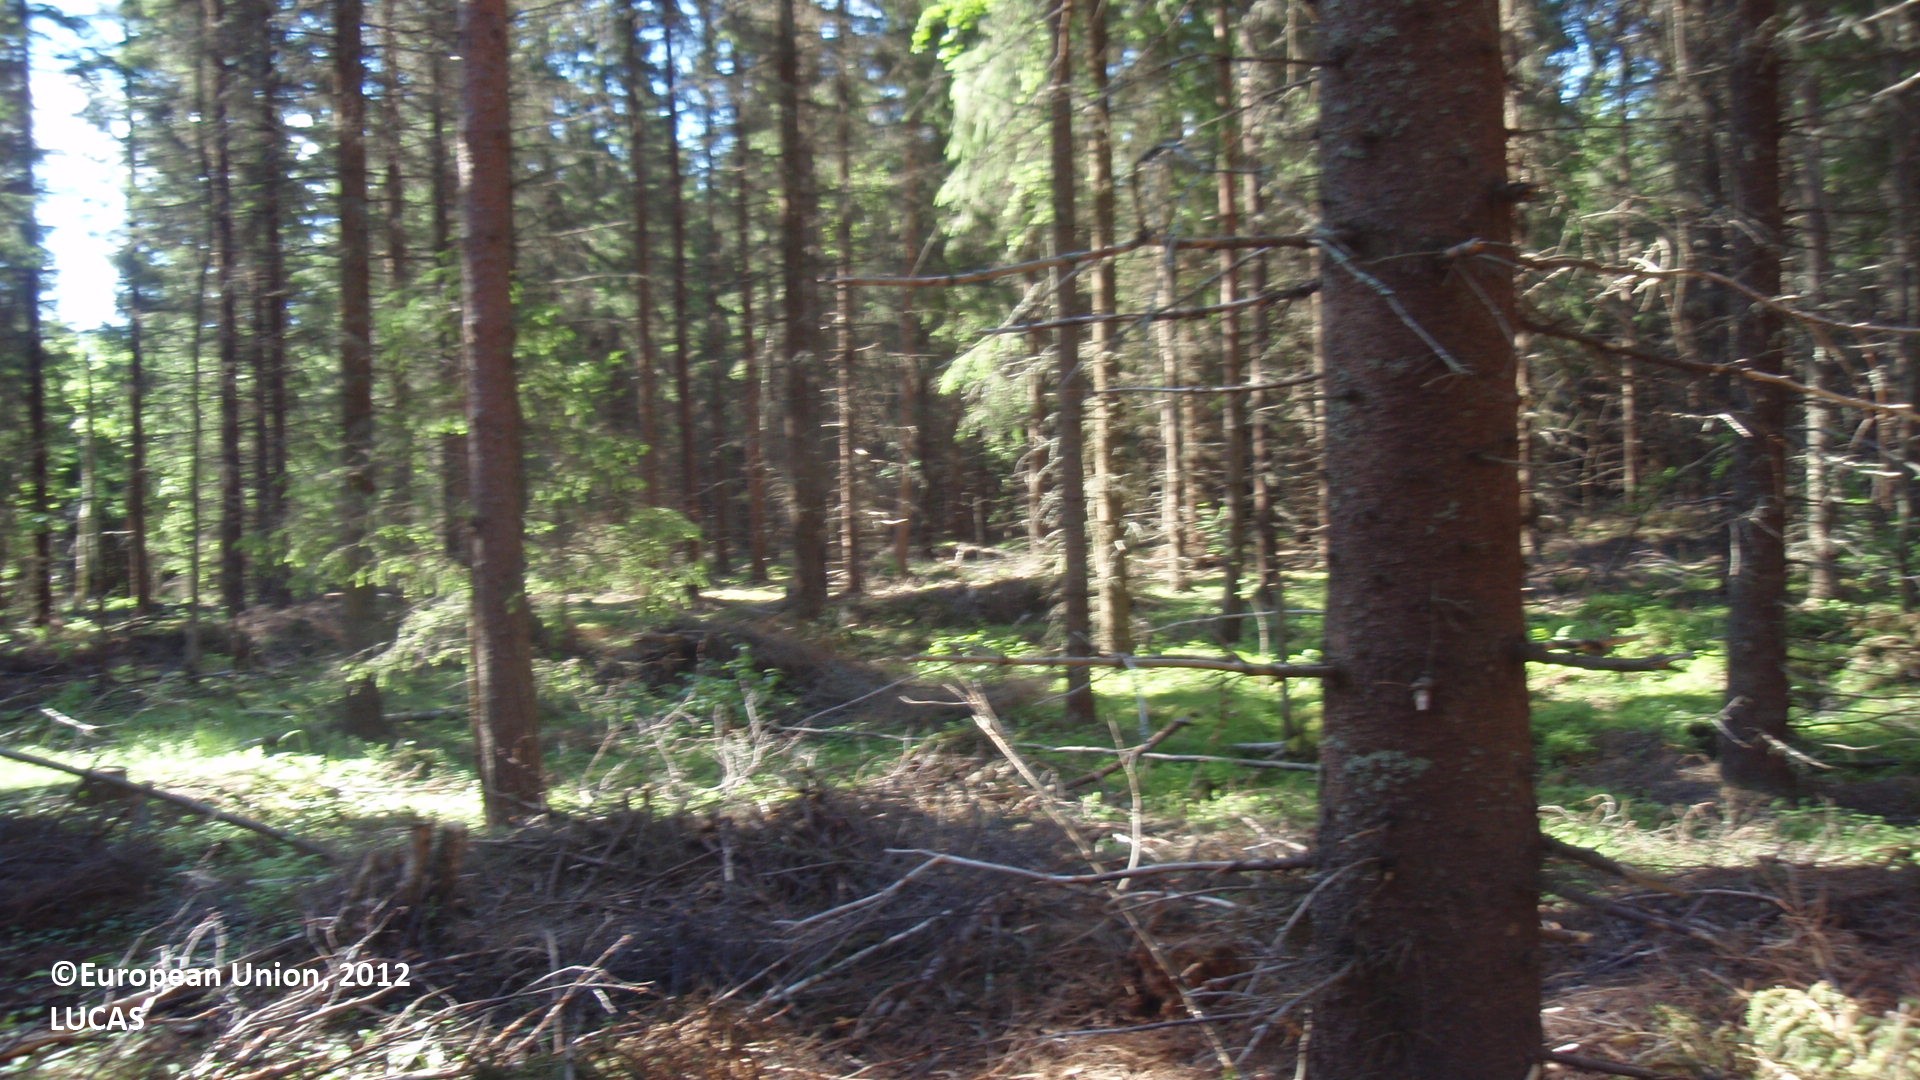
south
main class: Woodland
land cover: Spruce dominated coniferous woodland
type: boreal forest
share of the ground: 50 - 75 %
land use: Forestry
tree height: > 5 m
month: June
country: FI
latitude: 61.3978
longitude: 26.8040
